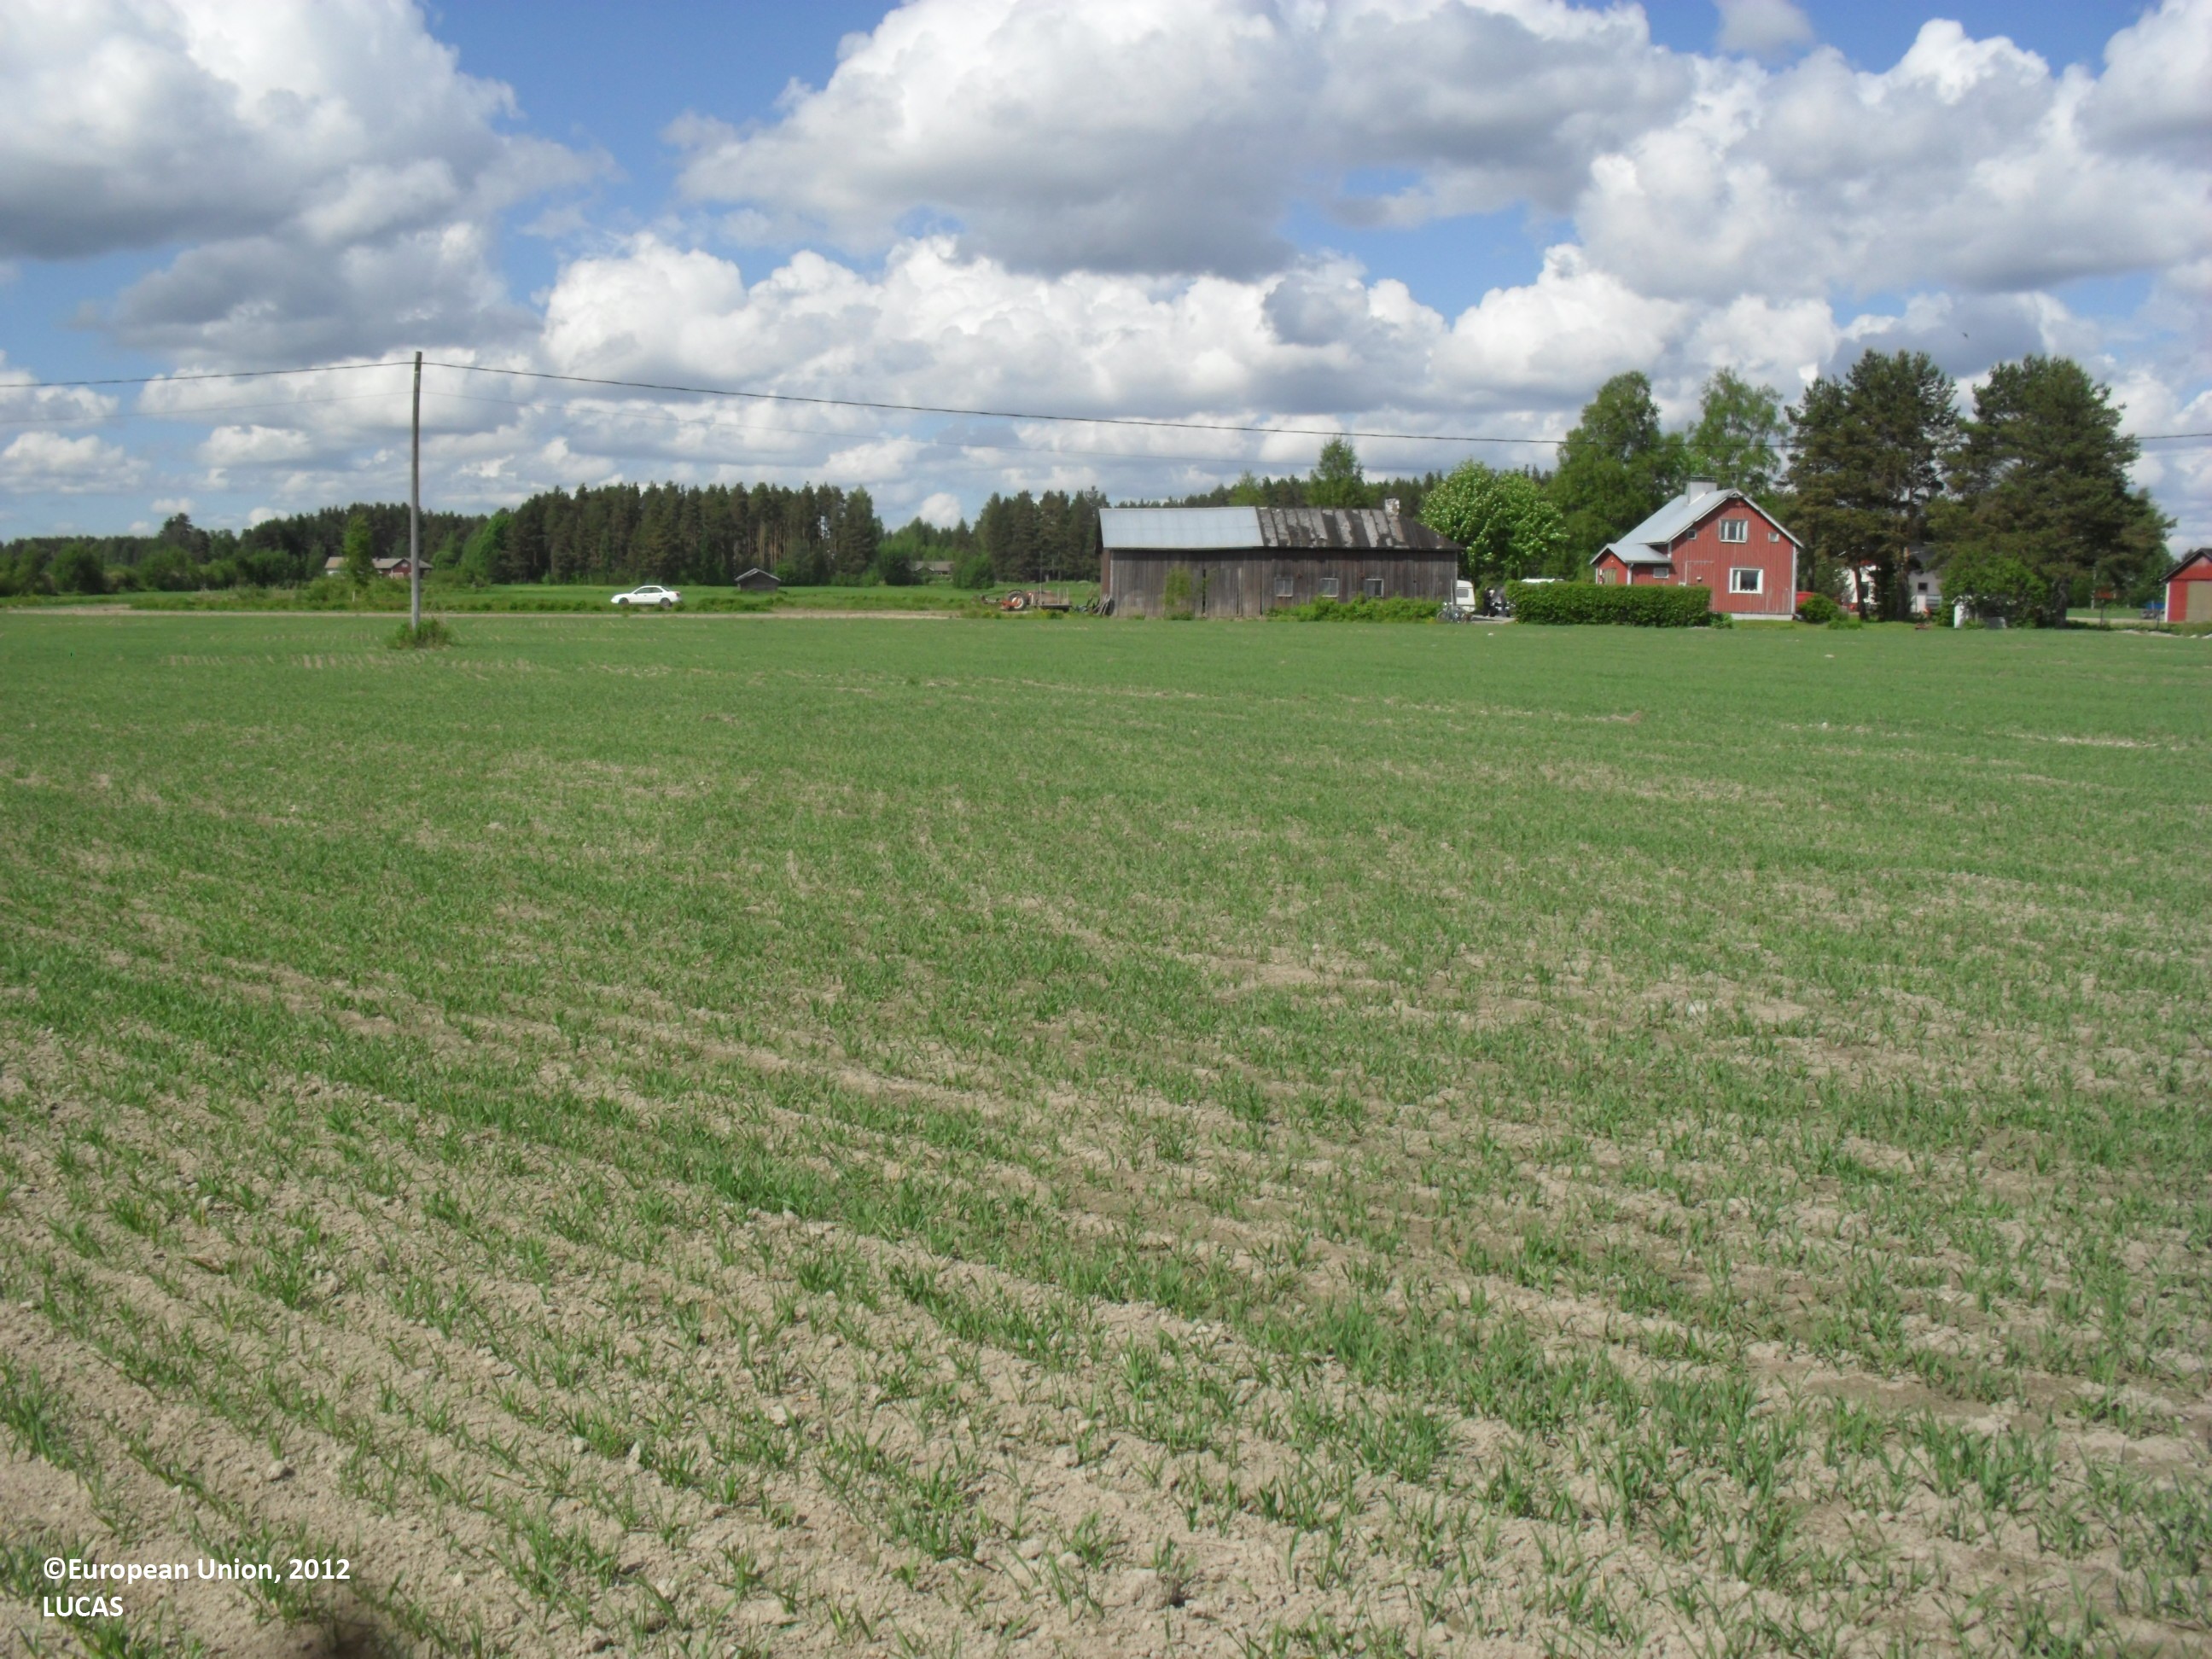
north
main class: Cropland
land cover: Barley
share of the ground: < 10 %
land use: Agriculture (excluding fallow land and kitchen gardens)
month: June
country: FI
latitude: 62.8463
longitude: 23.4822
